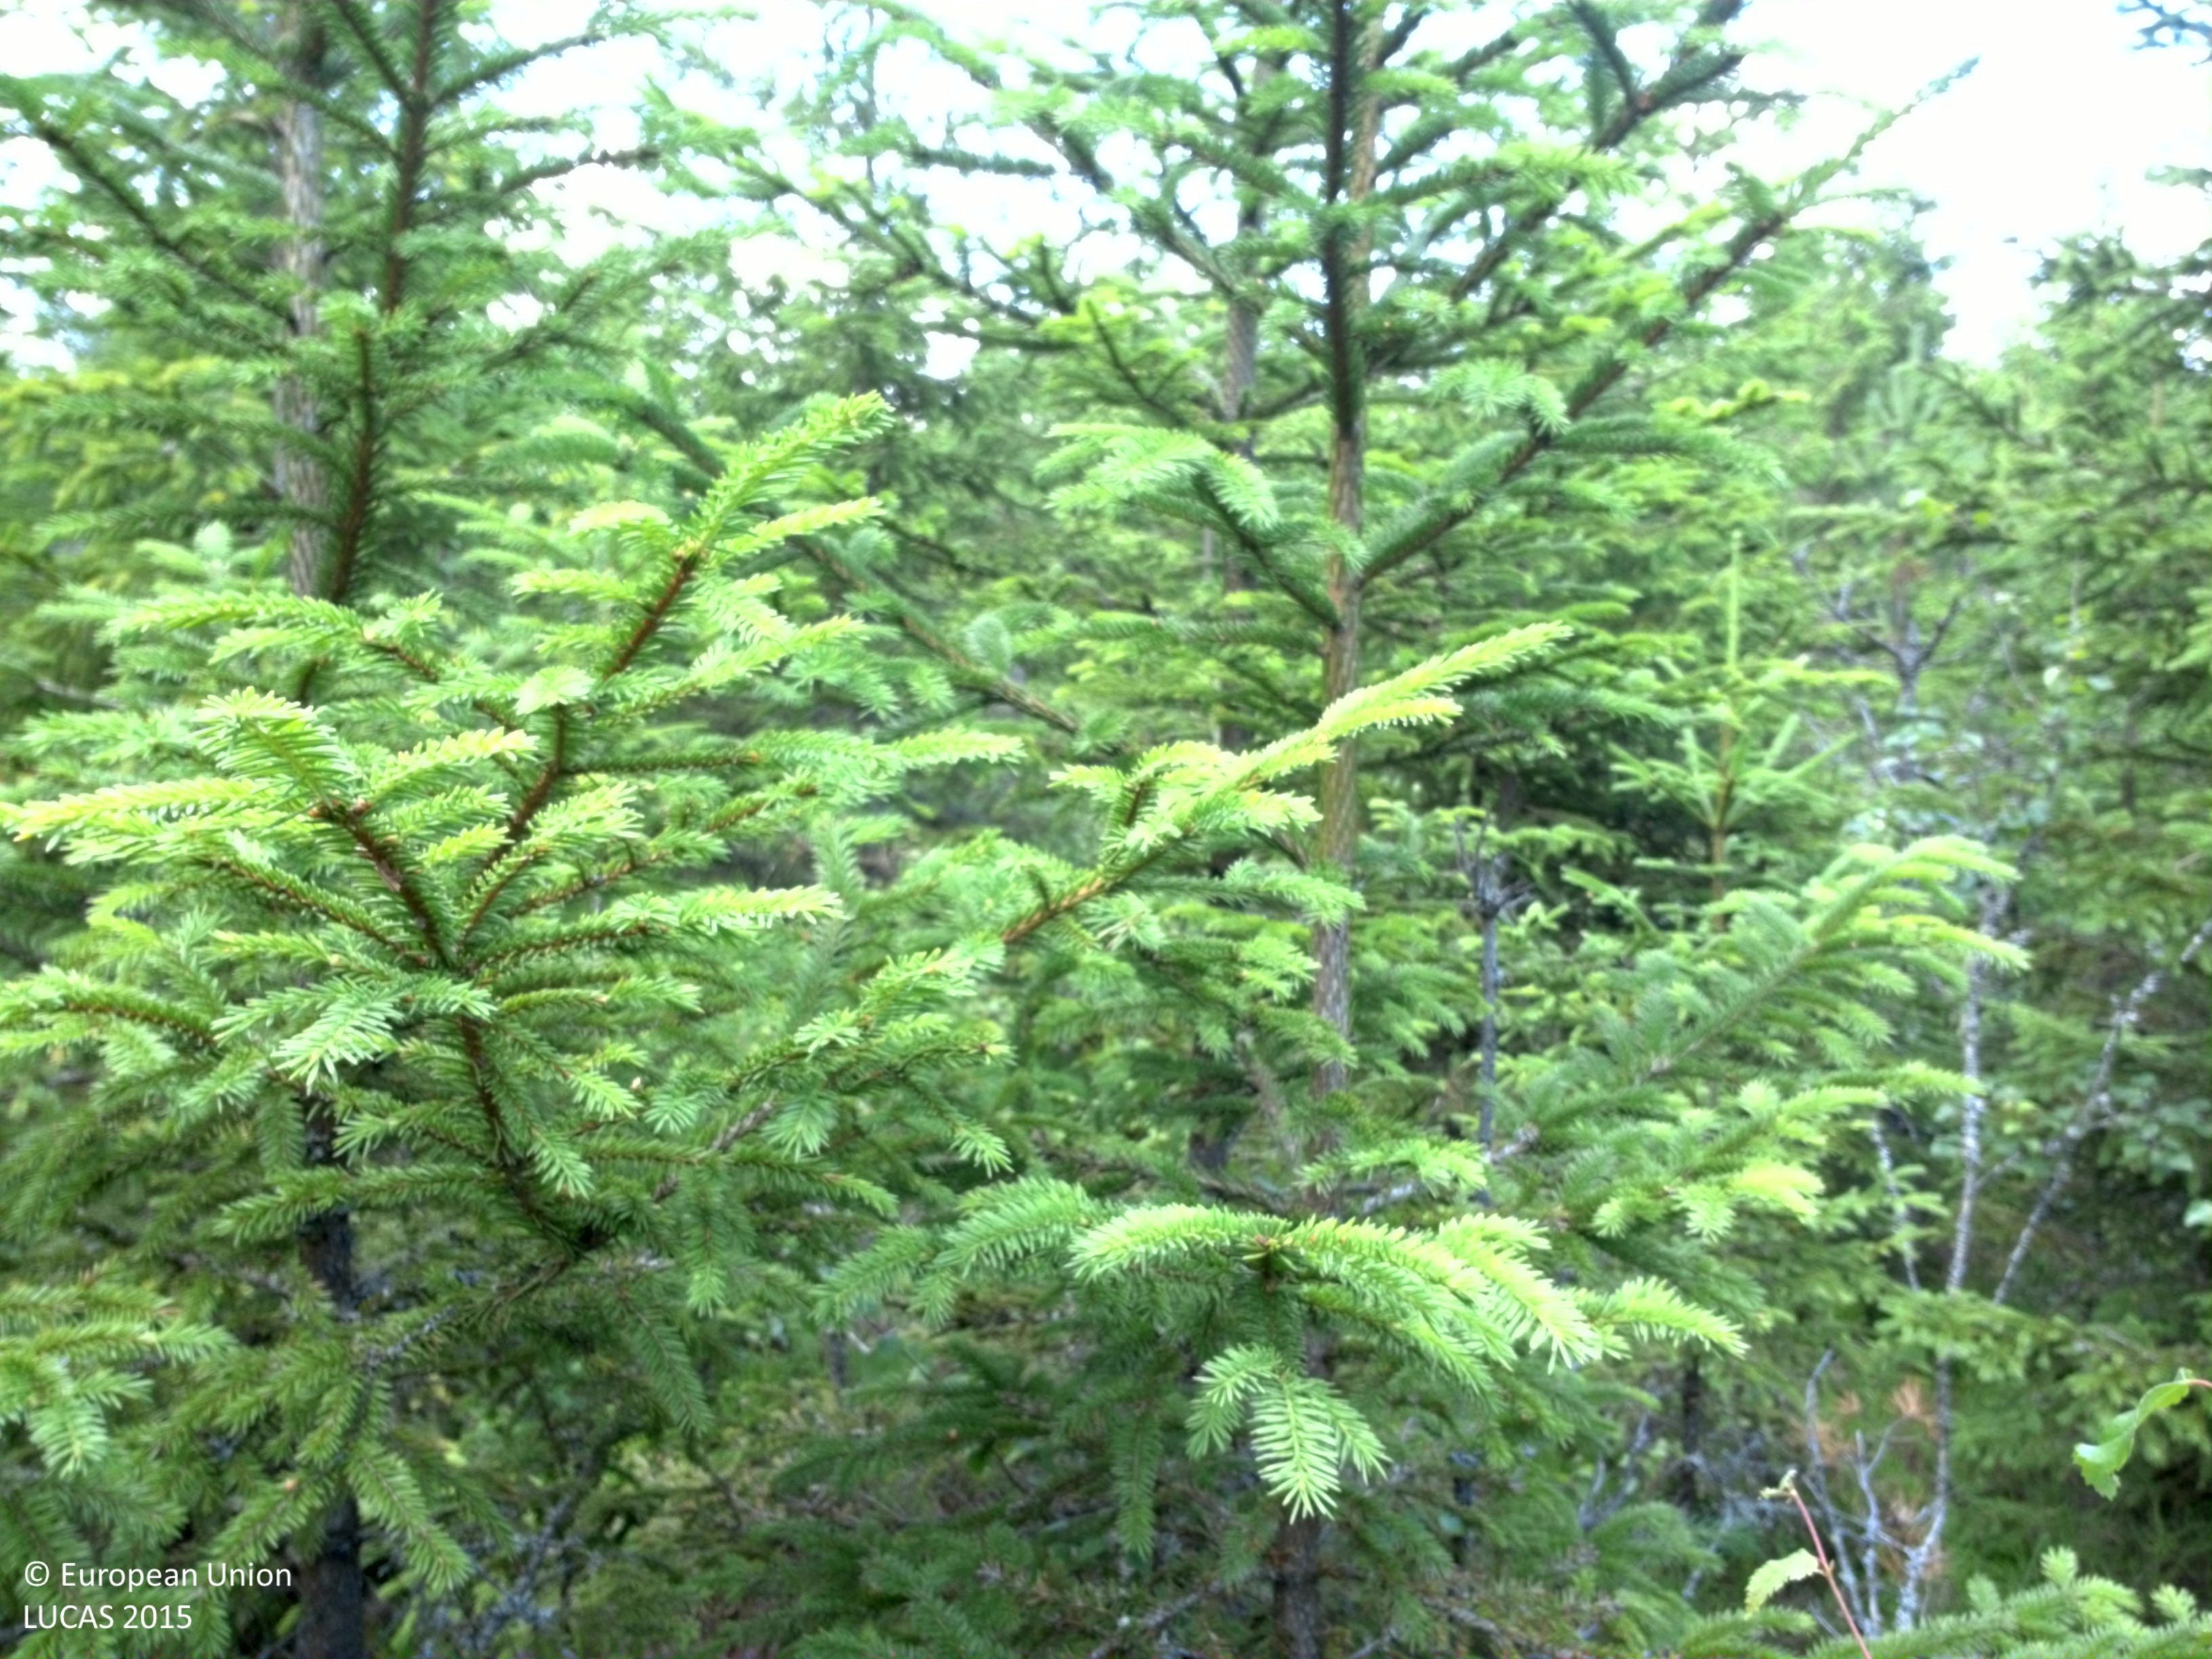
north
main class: Woodland
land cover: Spruce dominated mixed woodland
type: boreal forest
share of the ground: 50 - 75 %
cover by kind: coniferous forest trees 40 %, broadleaved forest trees 35 %, shrubs 20 %, lichens and mosses 5 %
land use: Forestry
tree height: < 5 m
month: July
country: SE
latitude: 58.5817
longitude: 14.3447
